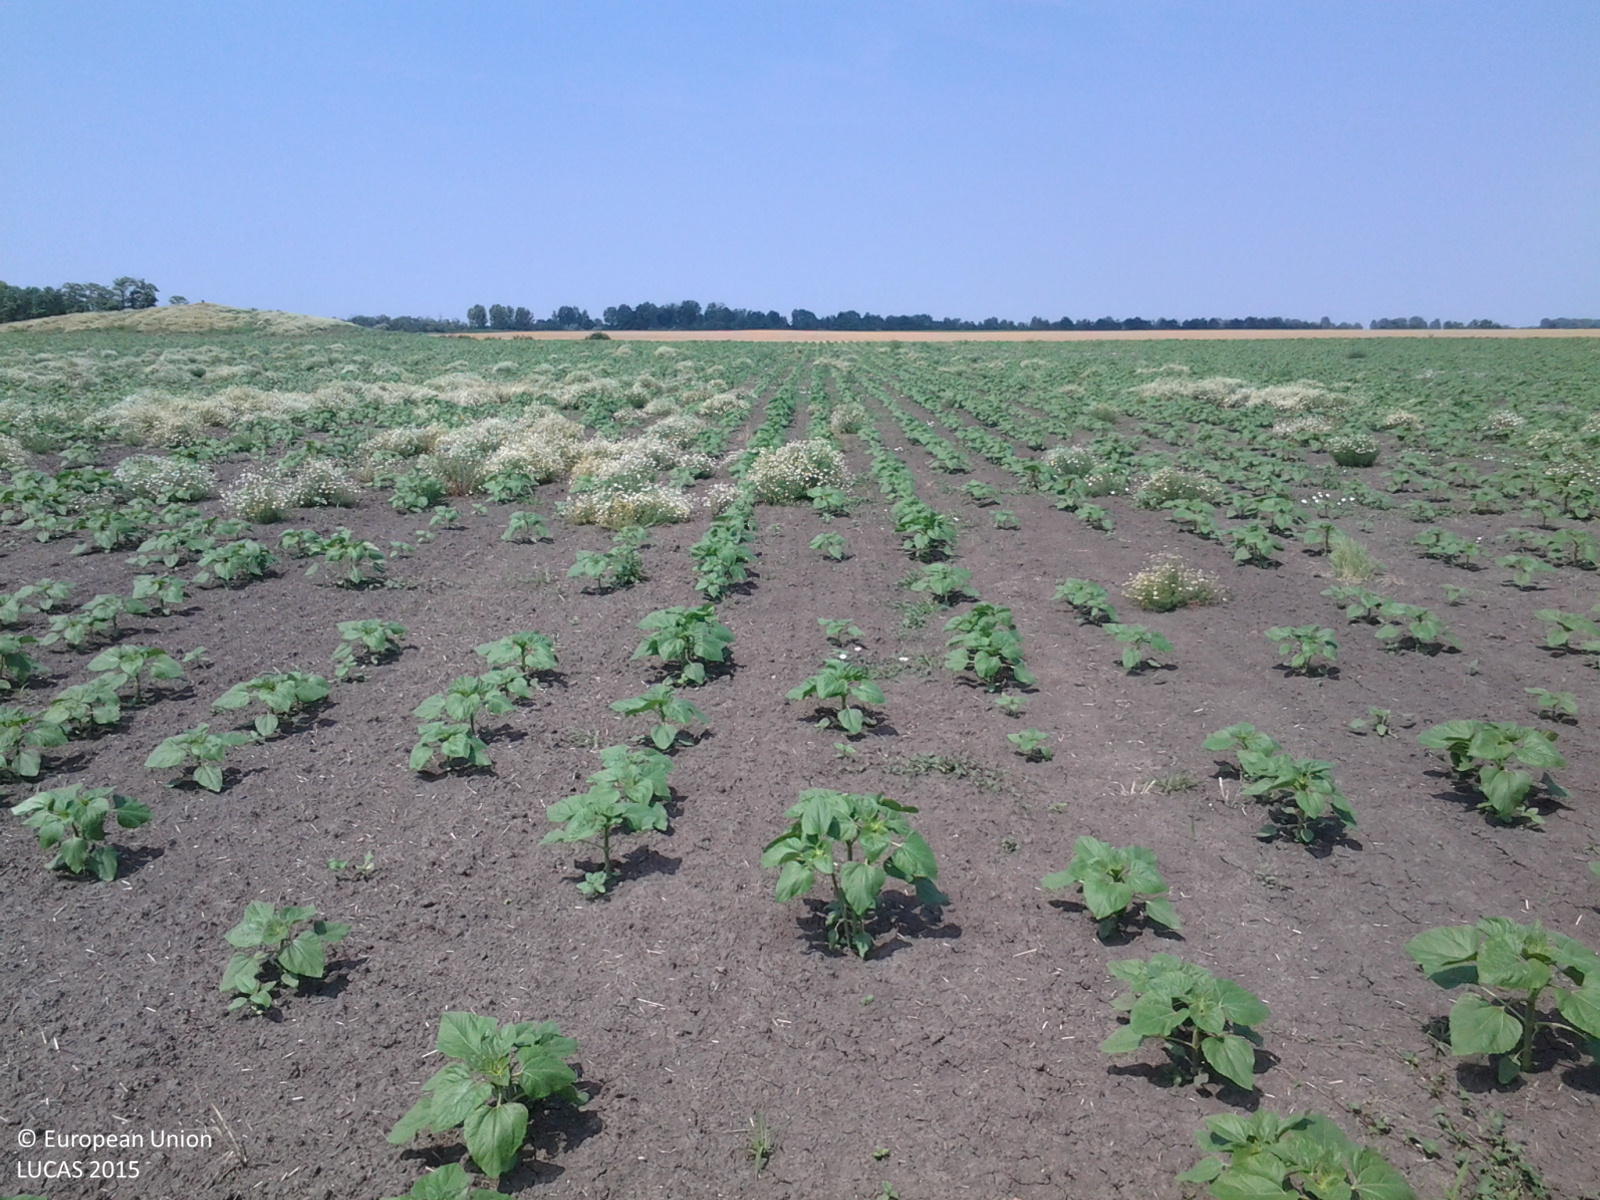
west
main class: Cropland
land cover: Sunflower
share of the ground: 25 - 50 %
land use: Agriculture (excluding fallow land and kitchen gardens)
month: July
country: HU
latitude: 46.9761
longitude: 20.5056
